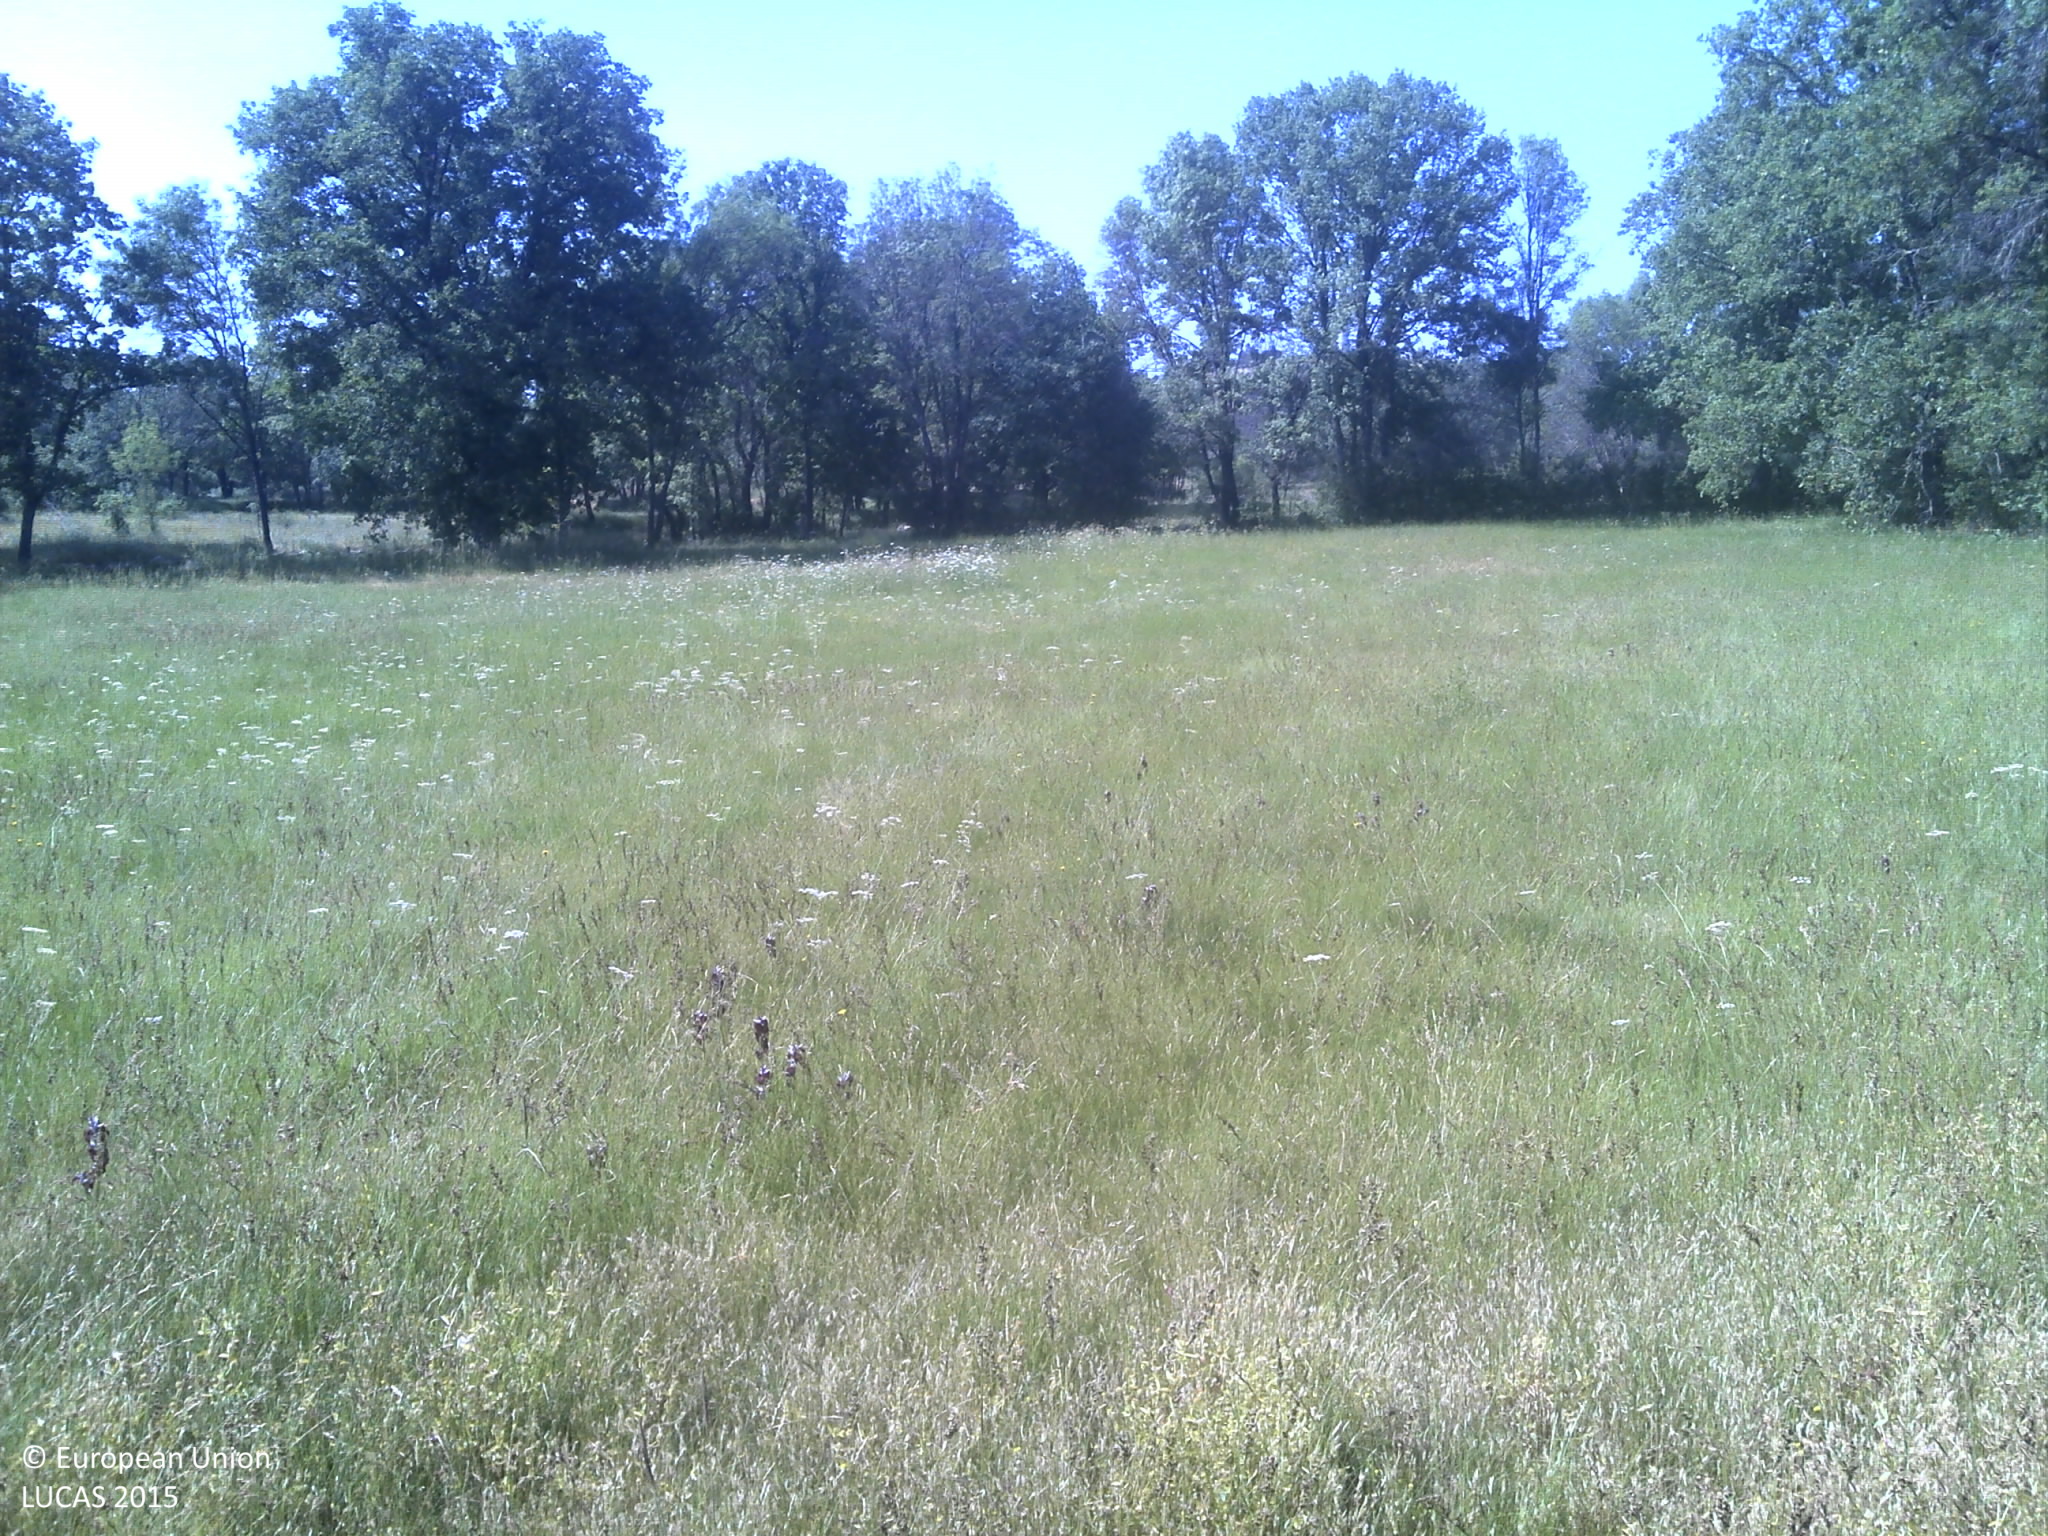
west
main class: Grassland
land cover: Grassland without tree/shrub cover
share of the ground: 50 - 75 %
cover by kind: herbaceous plants 75 %, unconsolidated bare surface 25 %
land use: Agriculture (excluding fallow land and kitchen gardens)
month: June
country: PT
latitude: 40.4136
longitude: -7.2017
